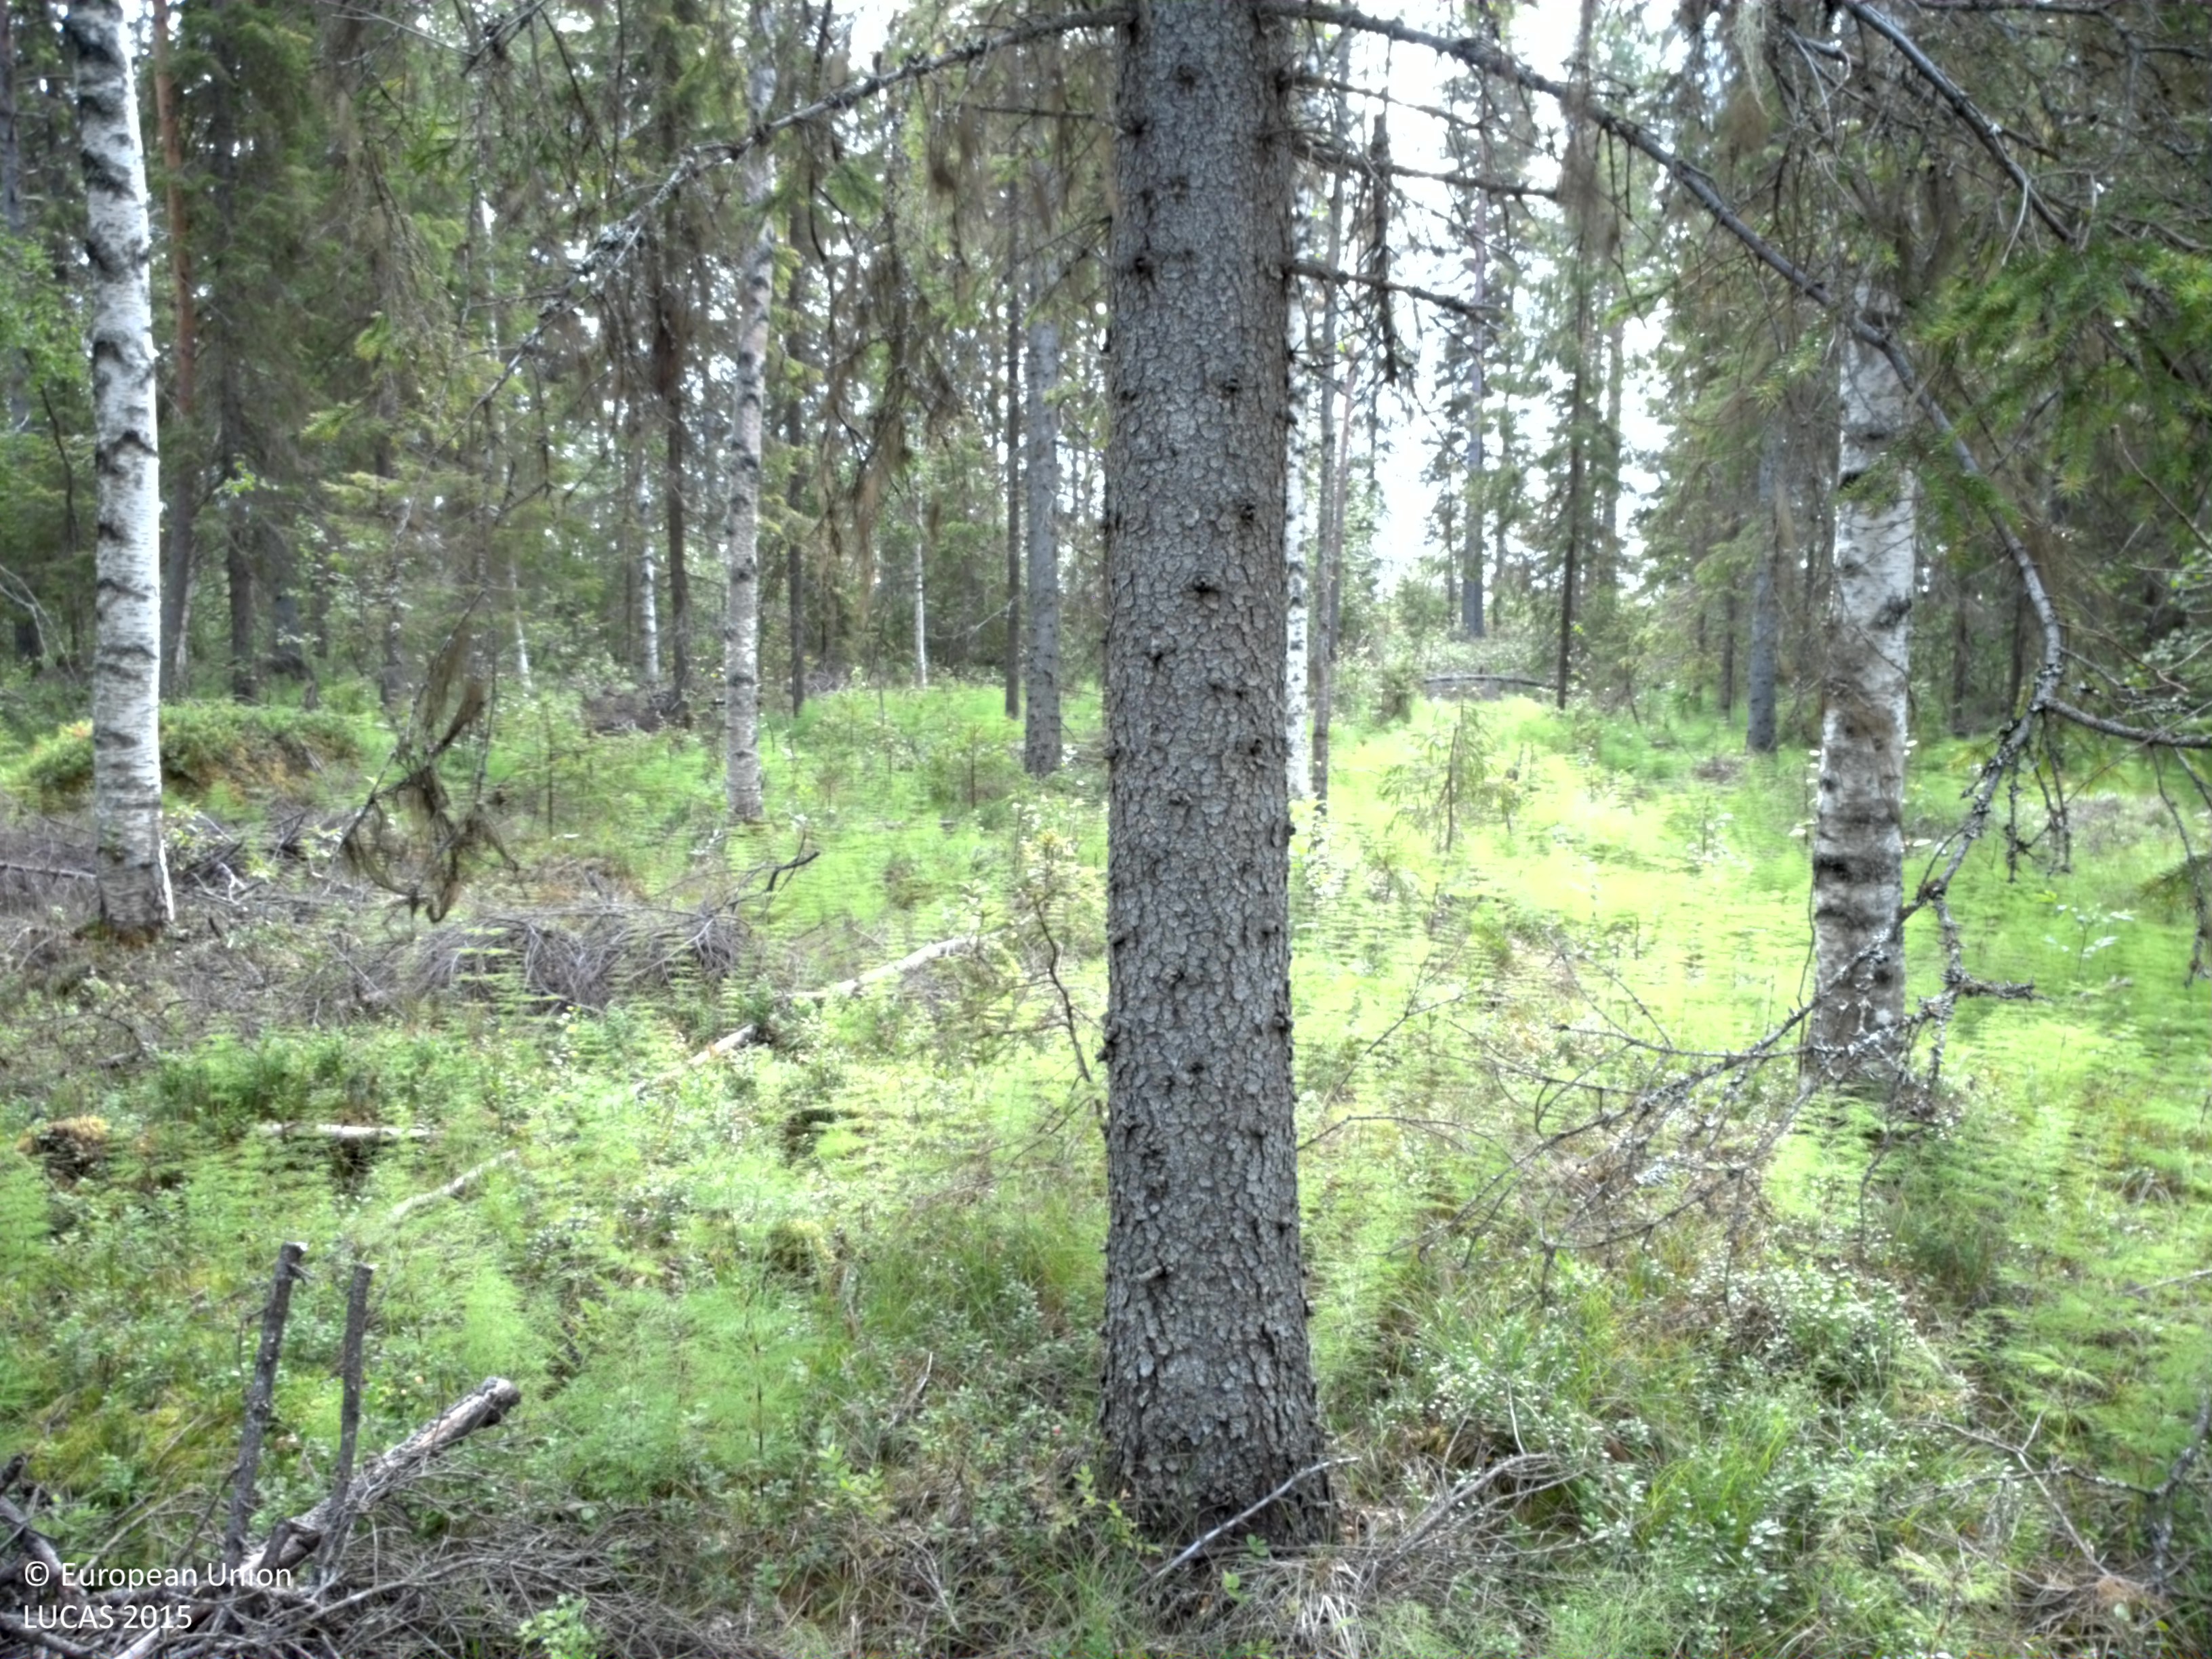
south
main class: Woodland
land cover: Spruce dominated mixed woodland
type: boreal forest
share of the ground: 25 - 50 %
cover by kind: shrubs 55 %, coniferous forest trees 30 %, broadleaved forest trees 10 %, lichens and mosses 5 %
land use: Forestry
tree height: > 5 m
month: August
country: SE
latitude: 65.9298
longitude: 22.6149
